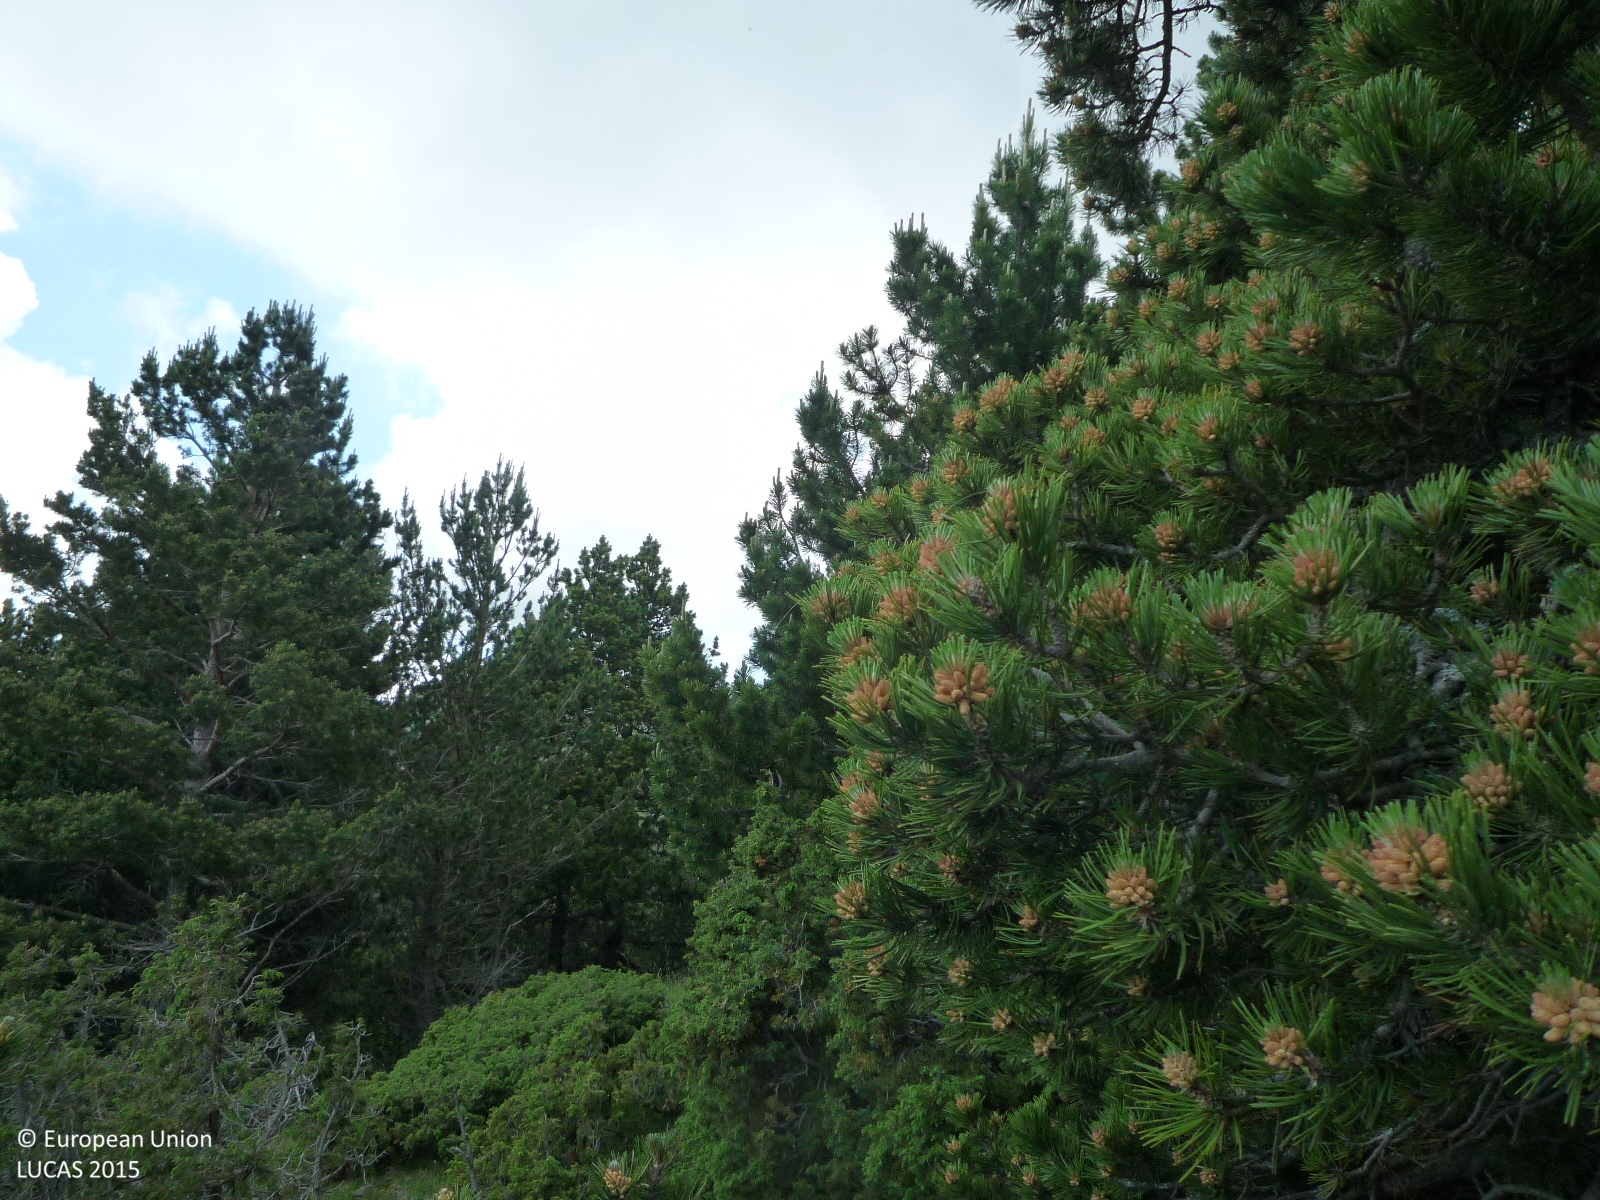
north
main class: Woodland
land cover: Pine dominated coniferous woodland
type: alpine coniferous forest
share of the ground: > 75 %
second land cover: Grassland without tree/shrub cover
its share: 50 - 75 %
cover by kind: coniferous forest trees 70 %, herbaceous plants 30 %
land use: Forestry
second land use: Agriculture (excluding fallow land and kitchen gardens)
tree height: < 5 m
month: June
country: ES
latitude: 42.2927
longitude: 1.8979
